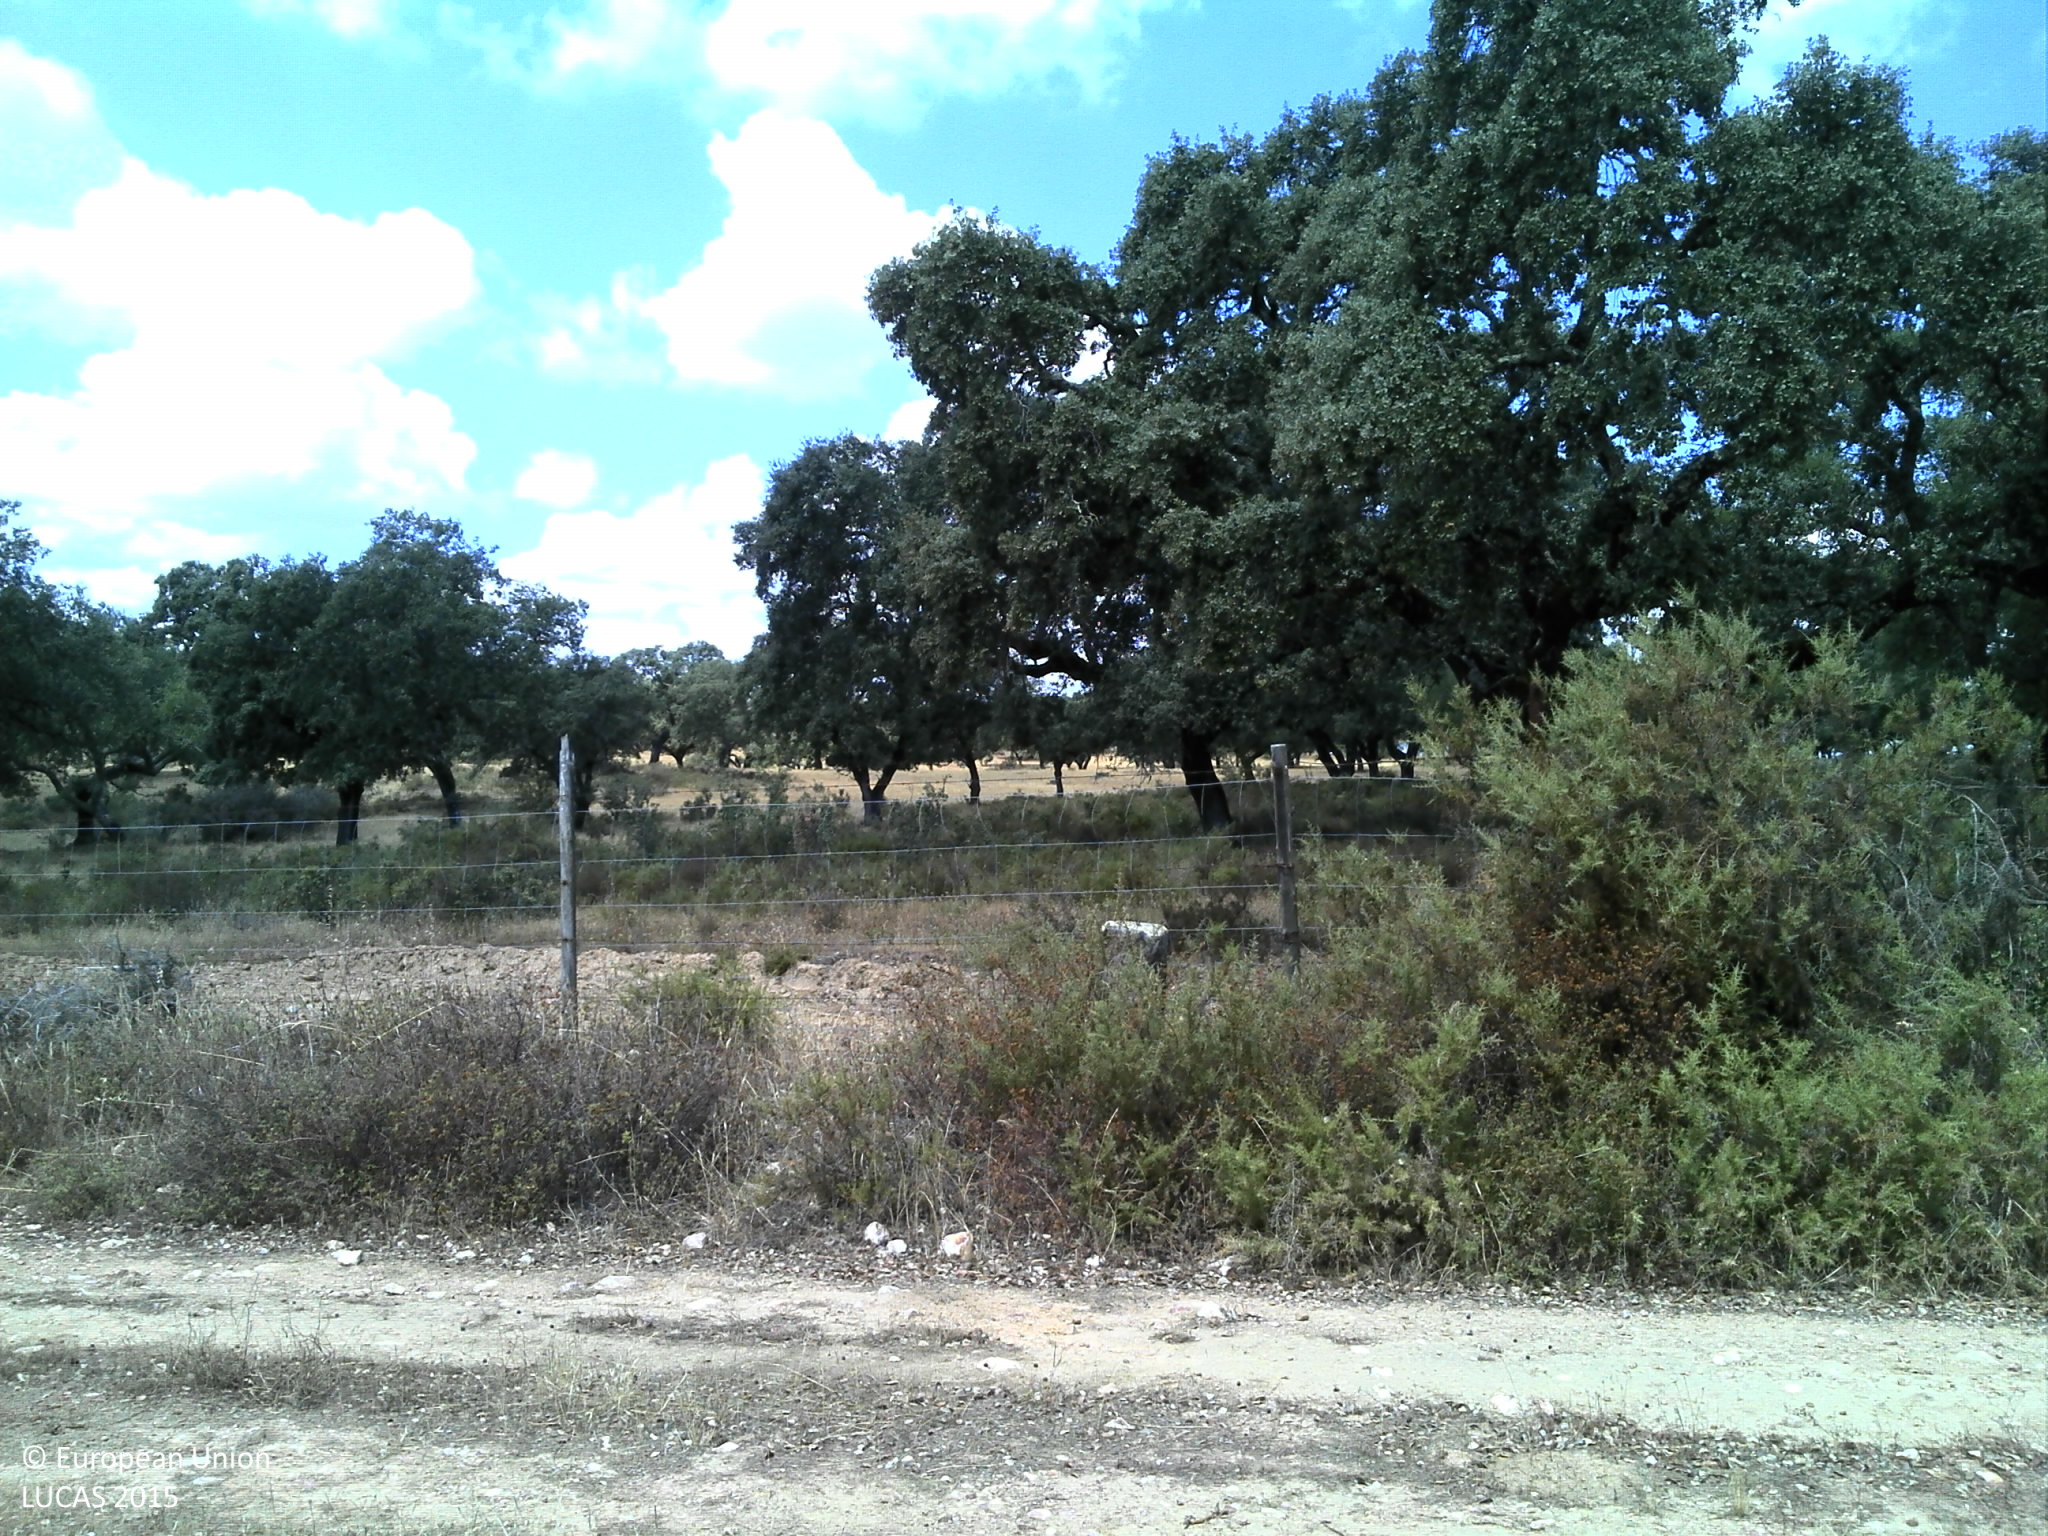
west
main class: Woodland
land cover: Broadleaved woodland
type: broadleaved evergreen forest
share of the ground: 25 - 50 %
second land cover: Grassland without tree/shrub cover
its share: 10 - 25 %
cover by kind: unconsolidated bare surface 55 %, broadleaved forest trees 30 %, herbaceous plants 15 %
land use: Forestry
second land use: Agriculture (excluding fallow land and kitchen gardens)
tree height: > 5 m
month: June
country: PT
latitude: 38.4980
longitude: -8.0784
